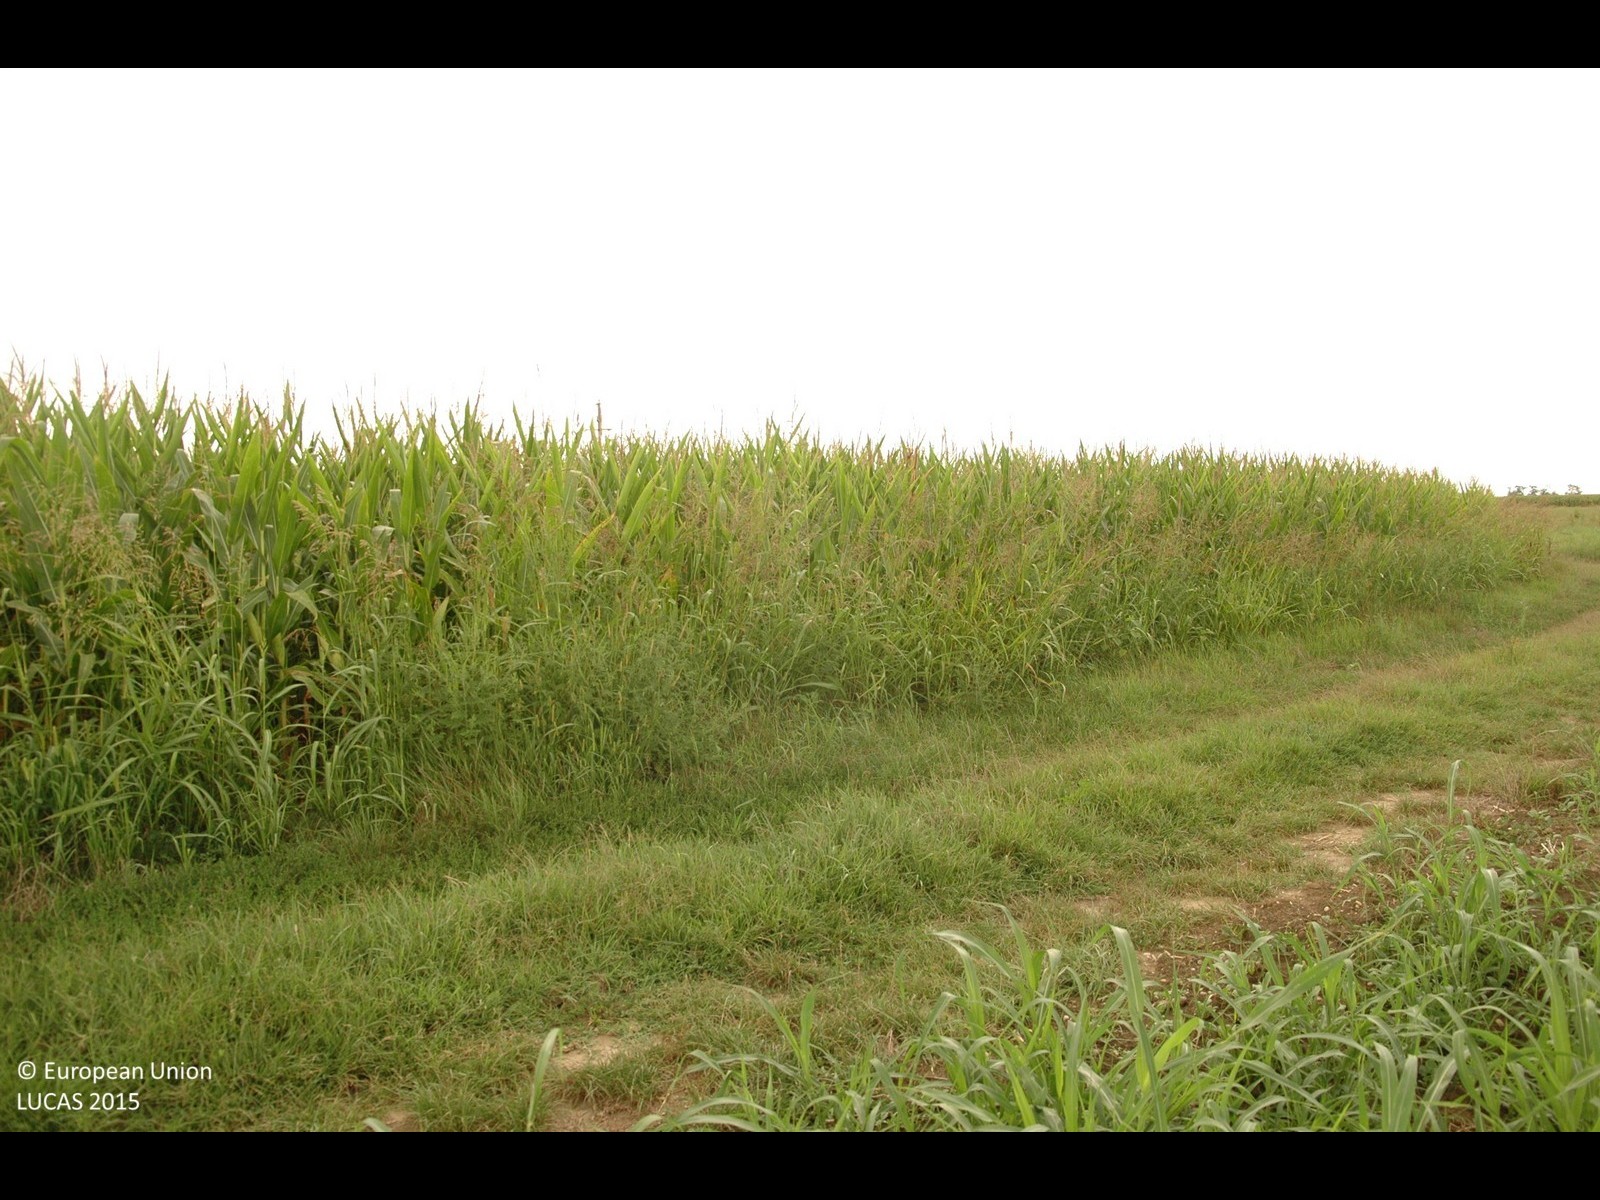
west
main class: Grassland
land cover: Grassland without tree/shrub cover
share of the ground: > 75 %
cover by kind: herbaceous plants 100 %
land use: Agriculture (excluding fallow land and kitchen gardens)
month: August
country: HR
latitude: 46.1608
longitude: 16.9558
